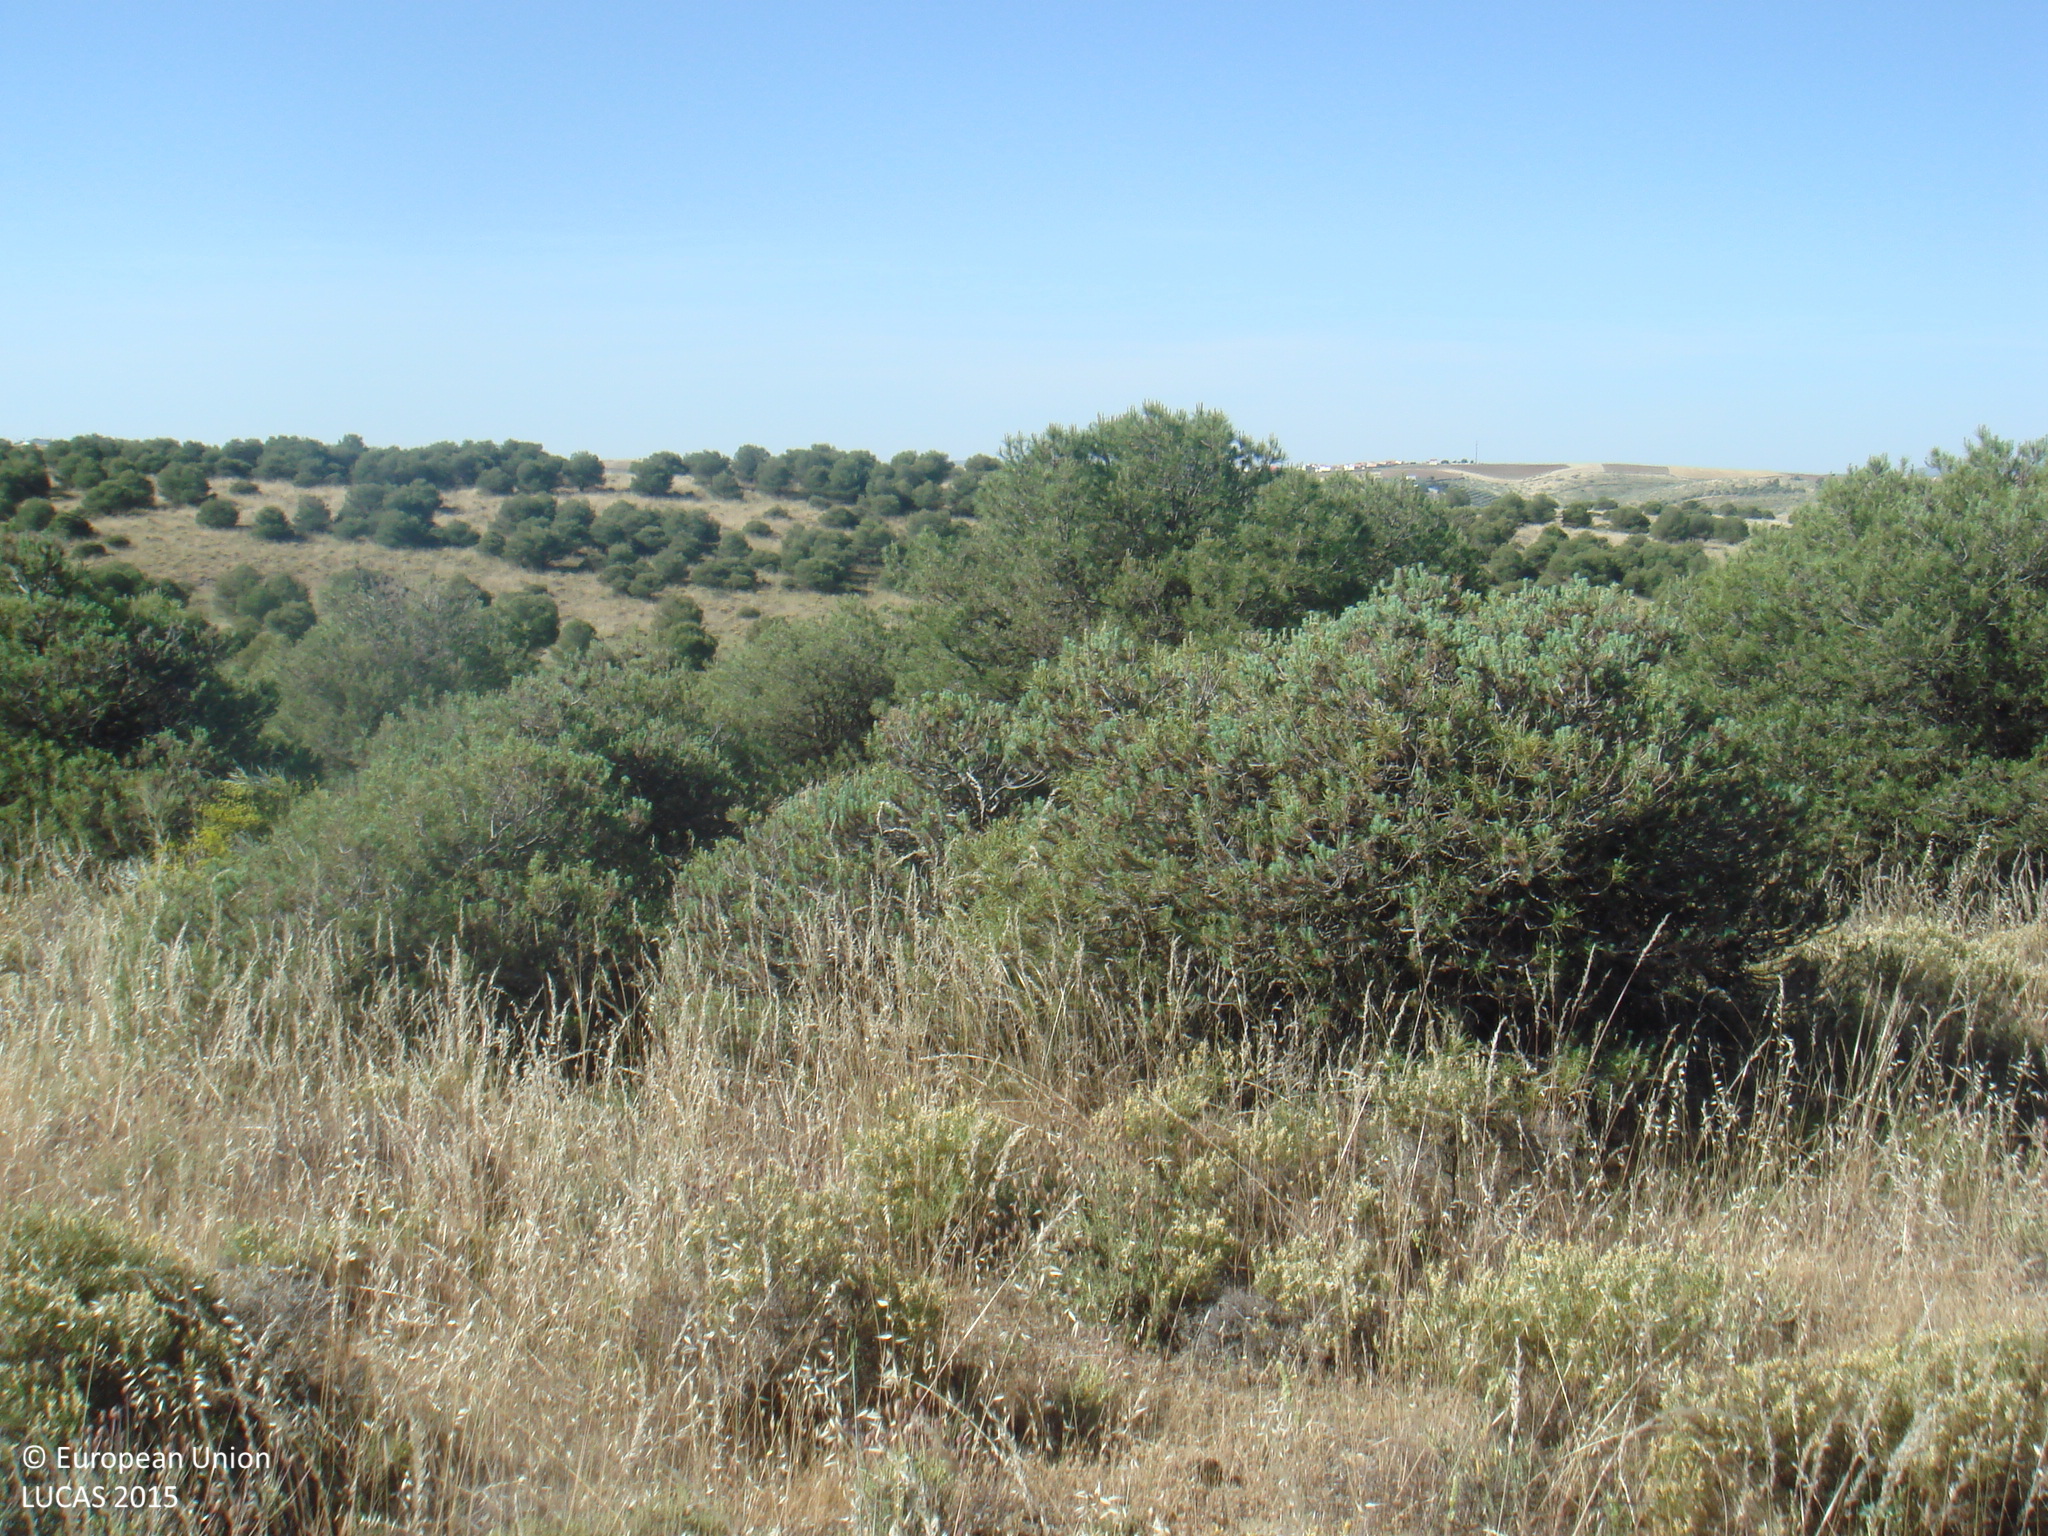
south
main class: Woodland
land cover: Pine dominated coniferous woodland
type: coniferous forest of the mediterranean region
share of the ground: 10 - 25 %
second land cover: Shrubland without tree cover
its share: 10 - 25 %
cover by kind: herbaceous plants 65 %, coniferous forest trees 25 %, shrubs 10 %
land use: Forestry
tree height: < 5 m
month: May
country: ES
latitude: 38.6045
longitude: -5.1548
